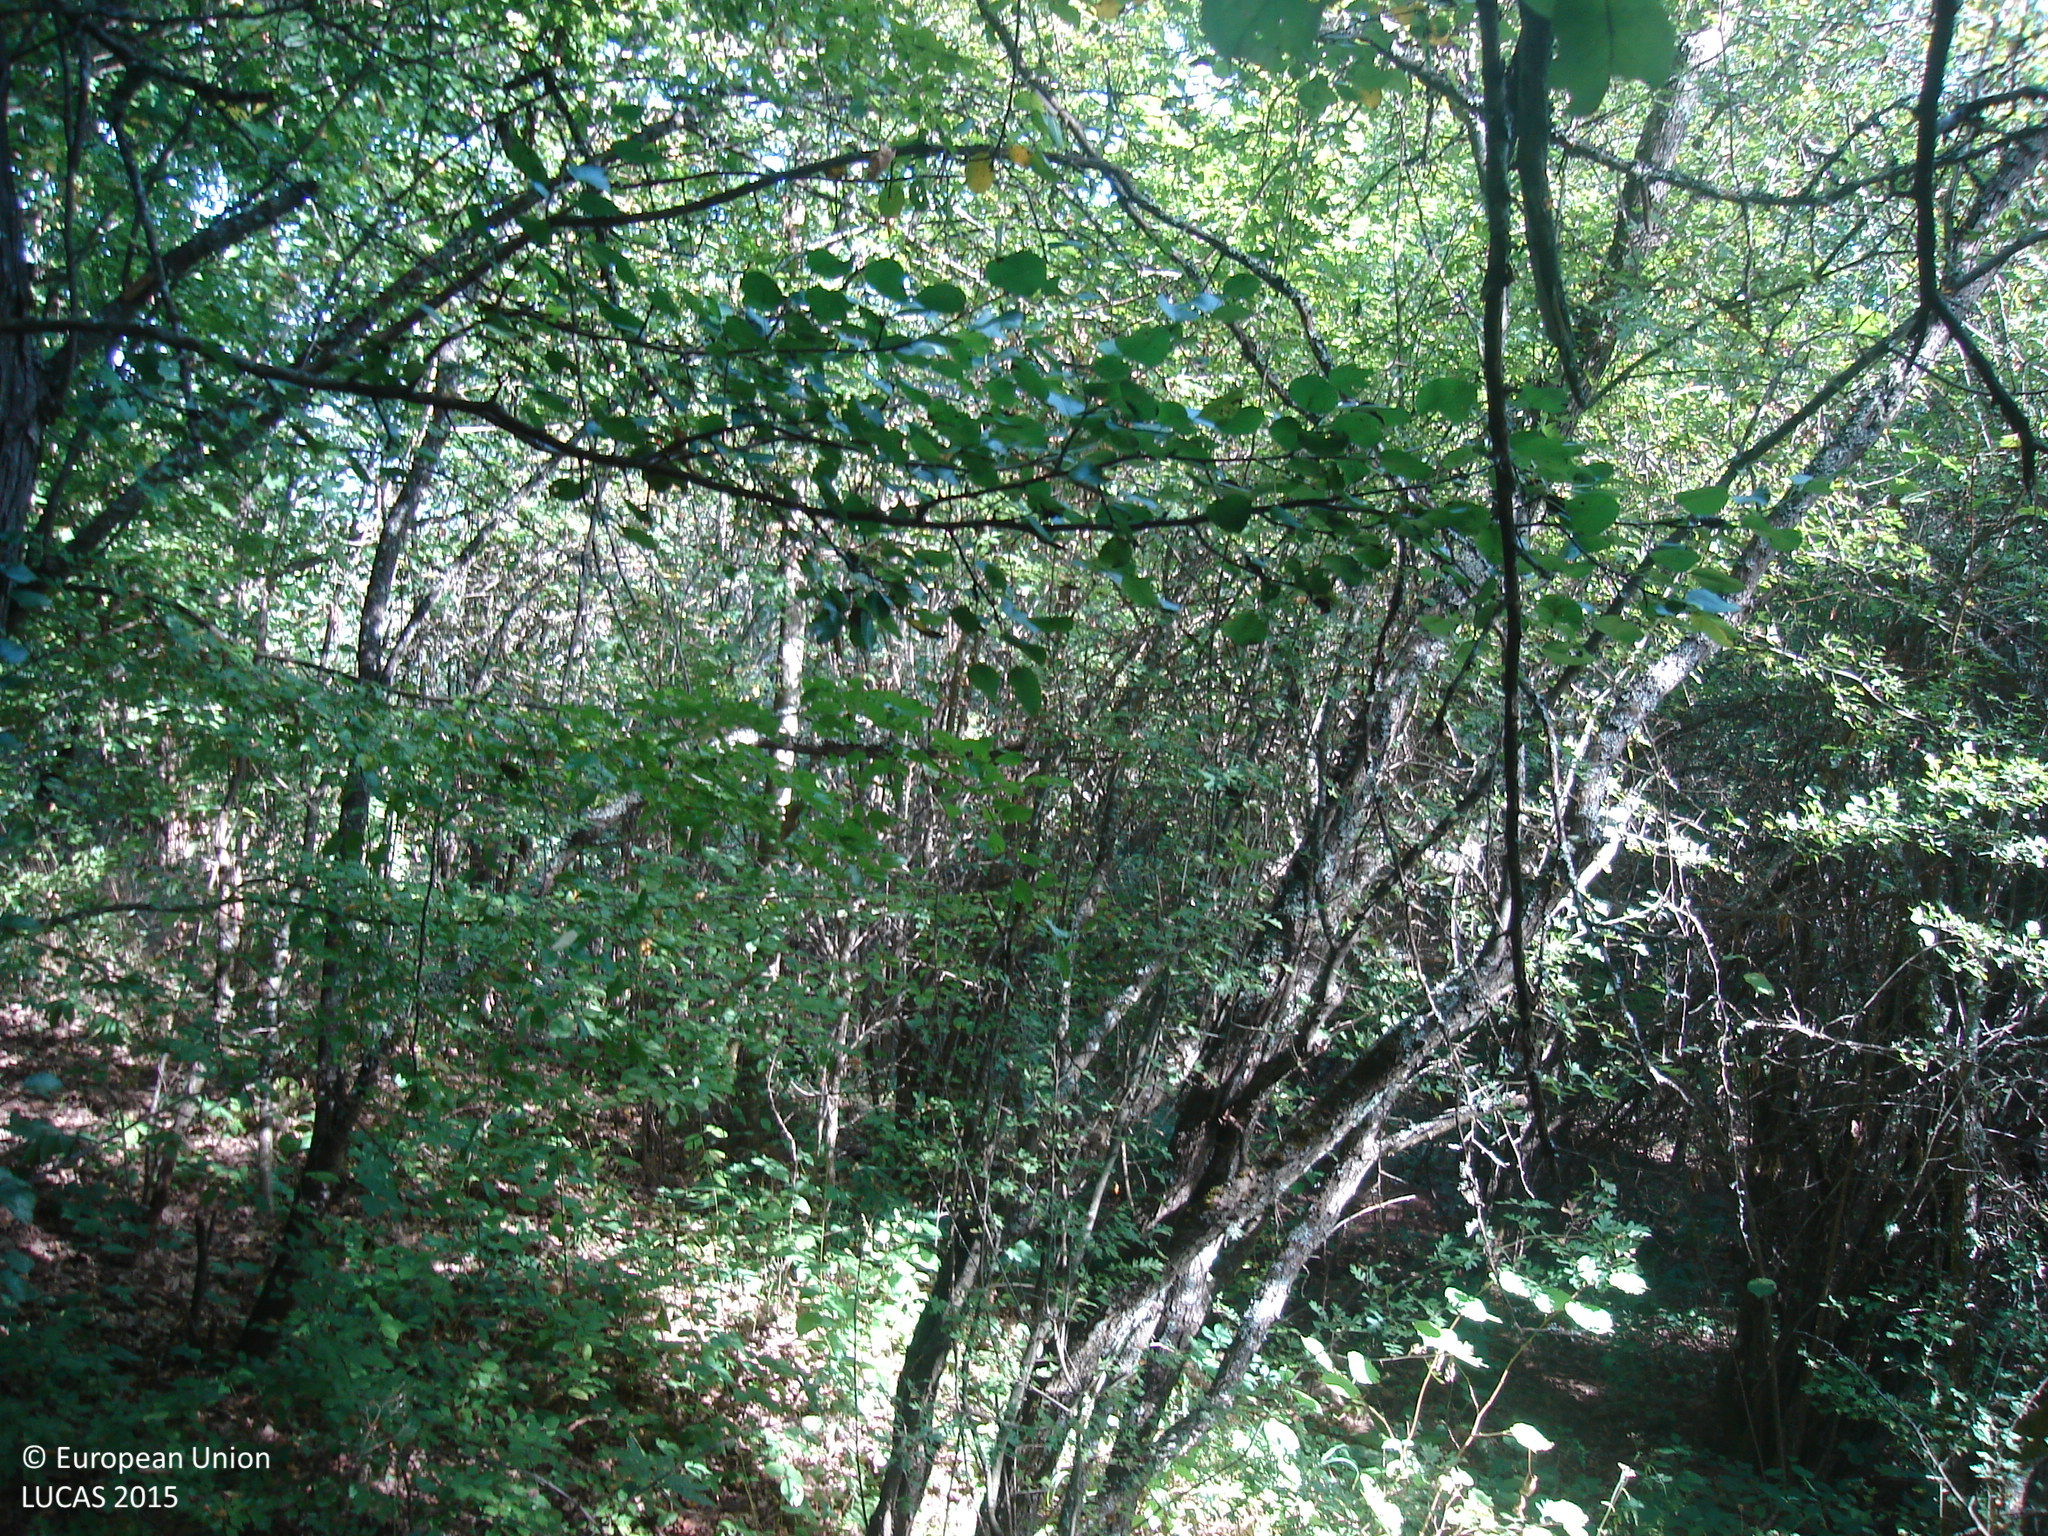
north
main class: Woodland
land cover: Broadleaved woodland
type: thermophilous deciduous forest
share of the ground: > 75 %
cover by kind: broadleaved forest trees 95 %, herbaceous plants 5 %
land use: Forestry
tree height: > 5 m
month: September
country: BG
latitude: 42.9840
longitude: 23.1194
